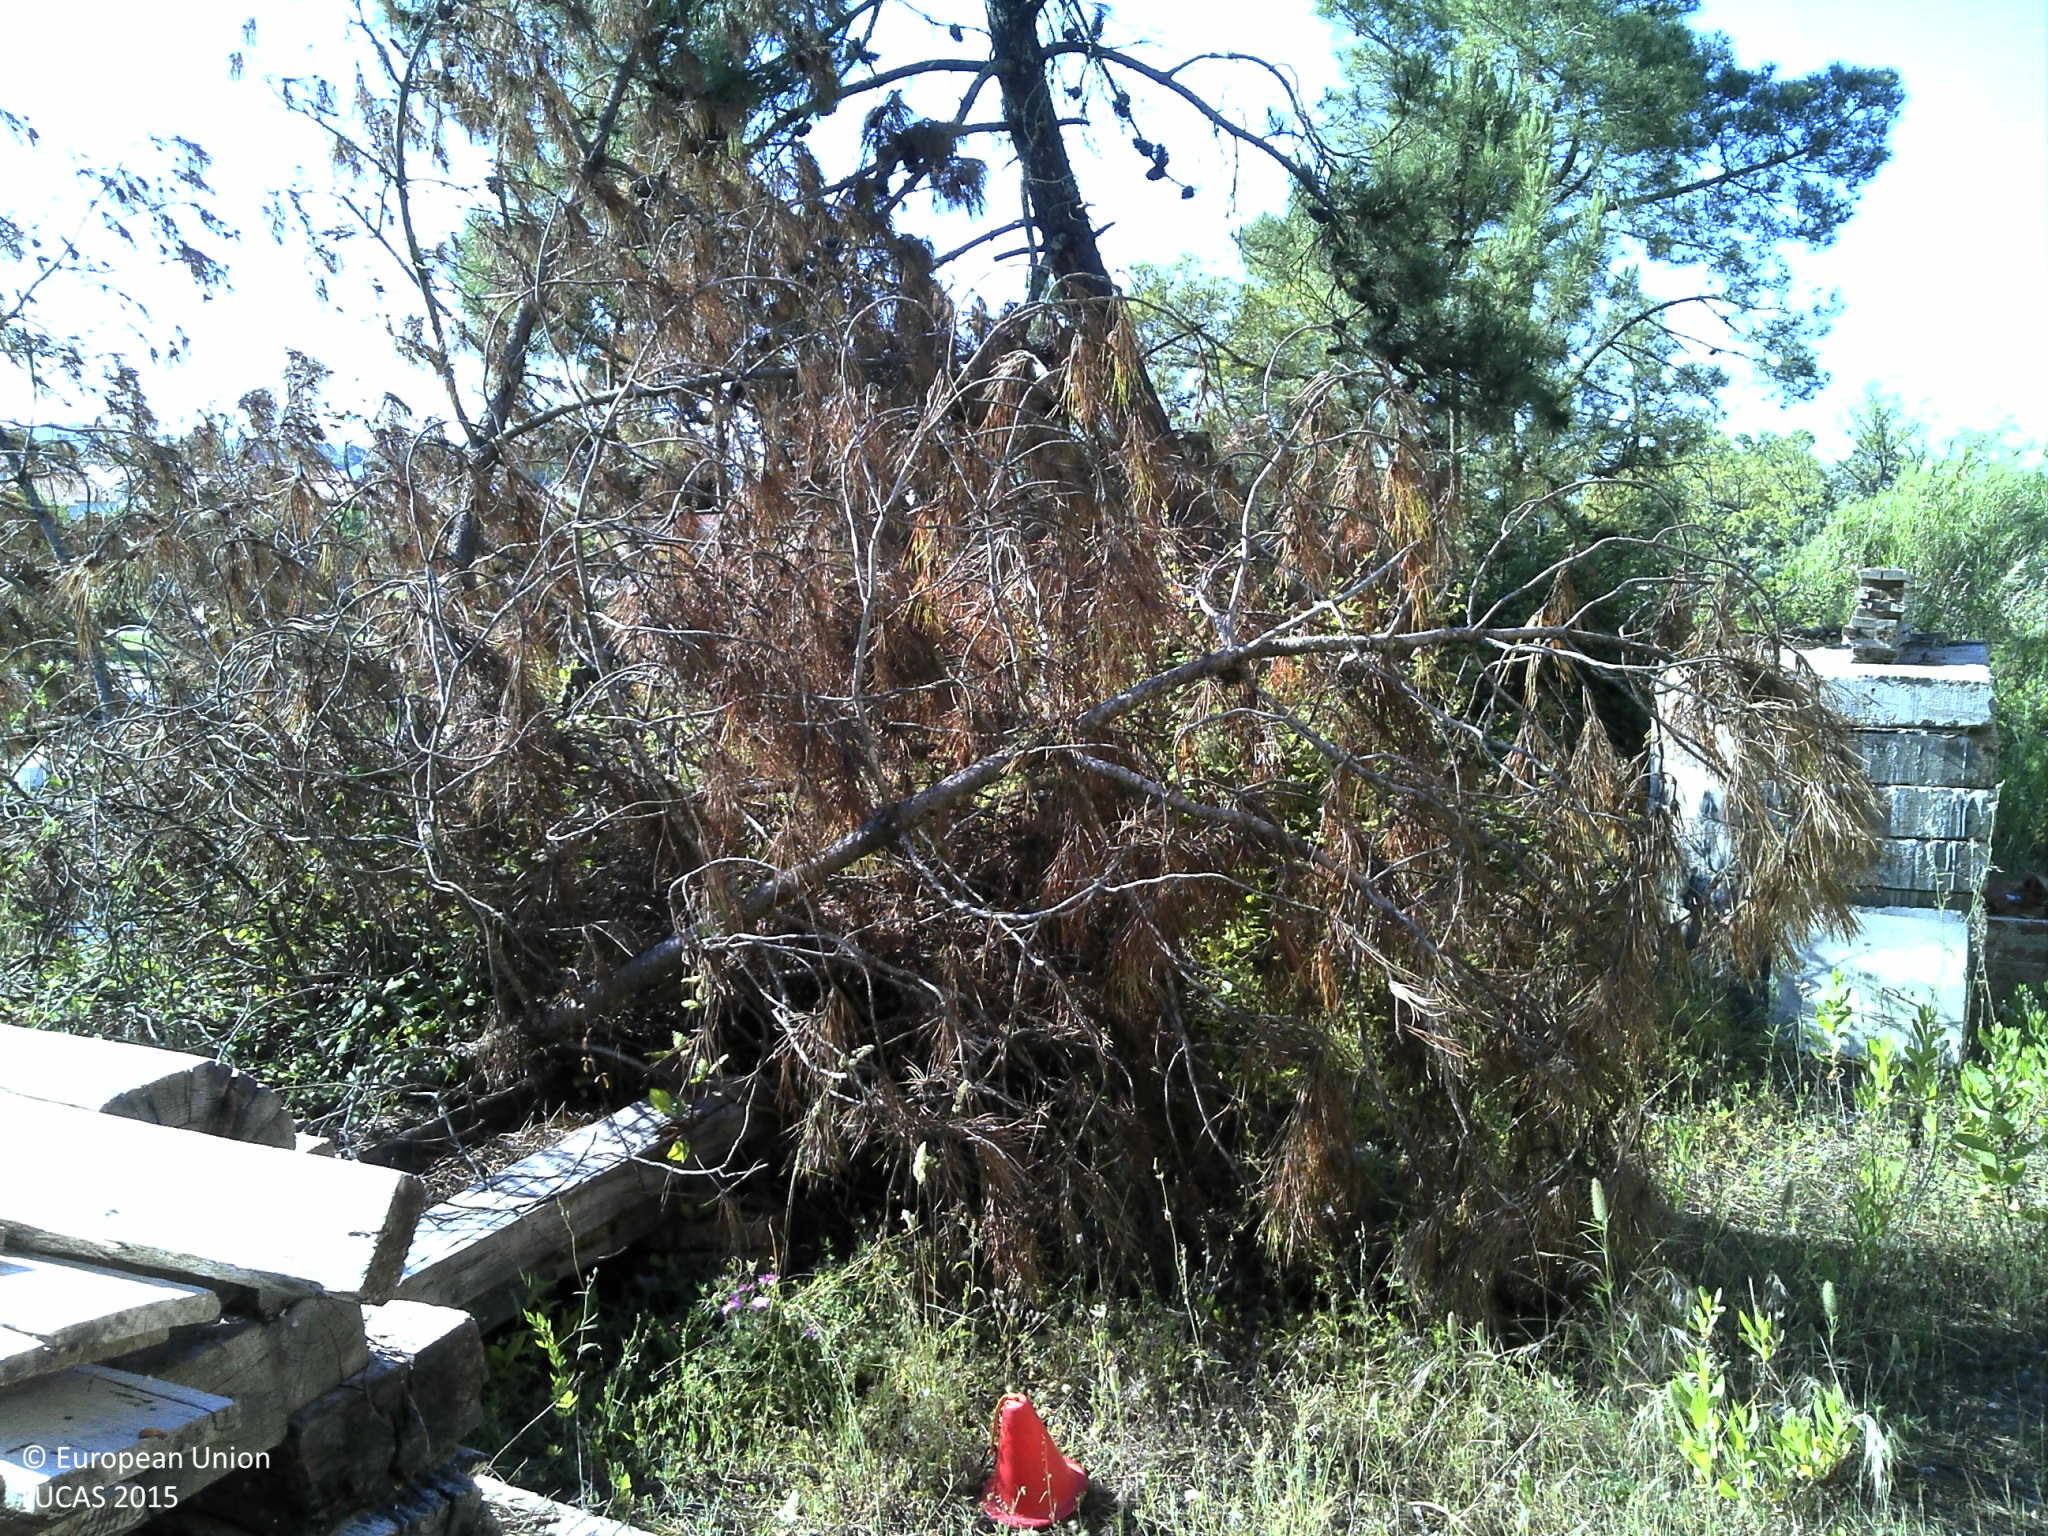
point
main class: Woodland
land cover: Pine dominated coniferous woodland
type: coniferous forest of the mediterranean region
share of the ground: 25 - 50 %
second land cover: Shrubland without tree cover
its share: 50 - 75 %
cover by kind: shrubs 50 %, coniferous forest trees 40 %, unconsolidated bare surface 10 %
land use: Abandoned areas
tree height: > 5 m
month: May
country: PT
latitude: 39.2516
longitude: -8.0043
